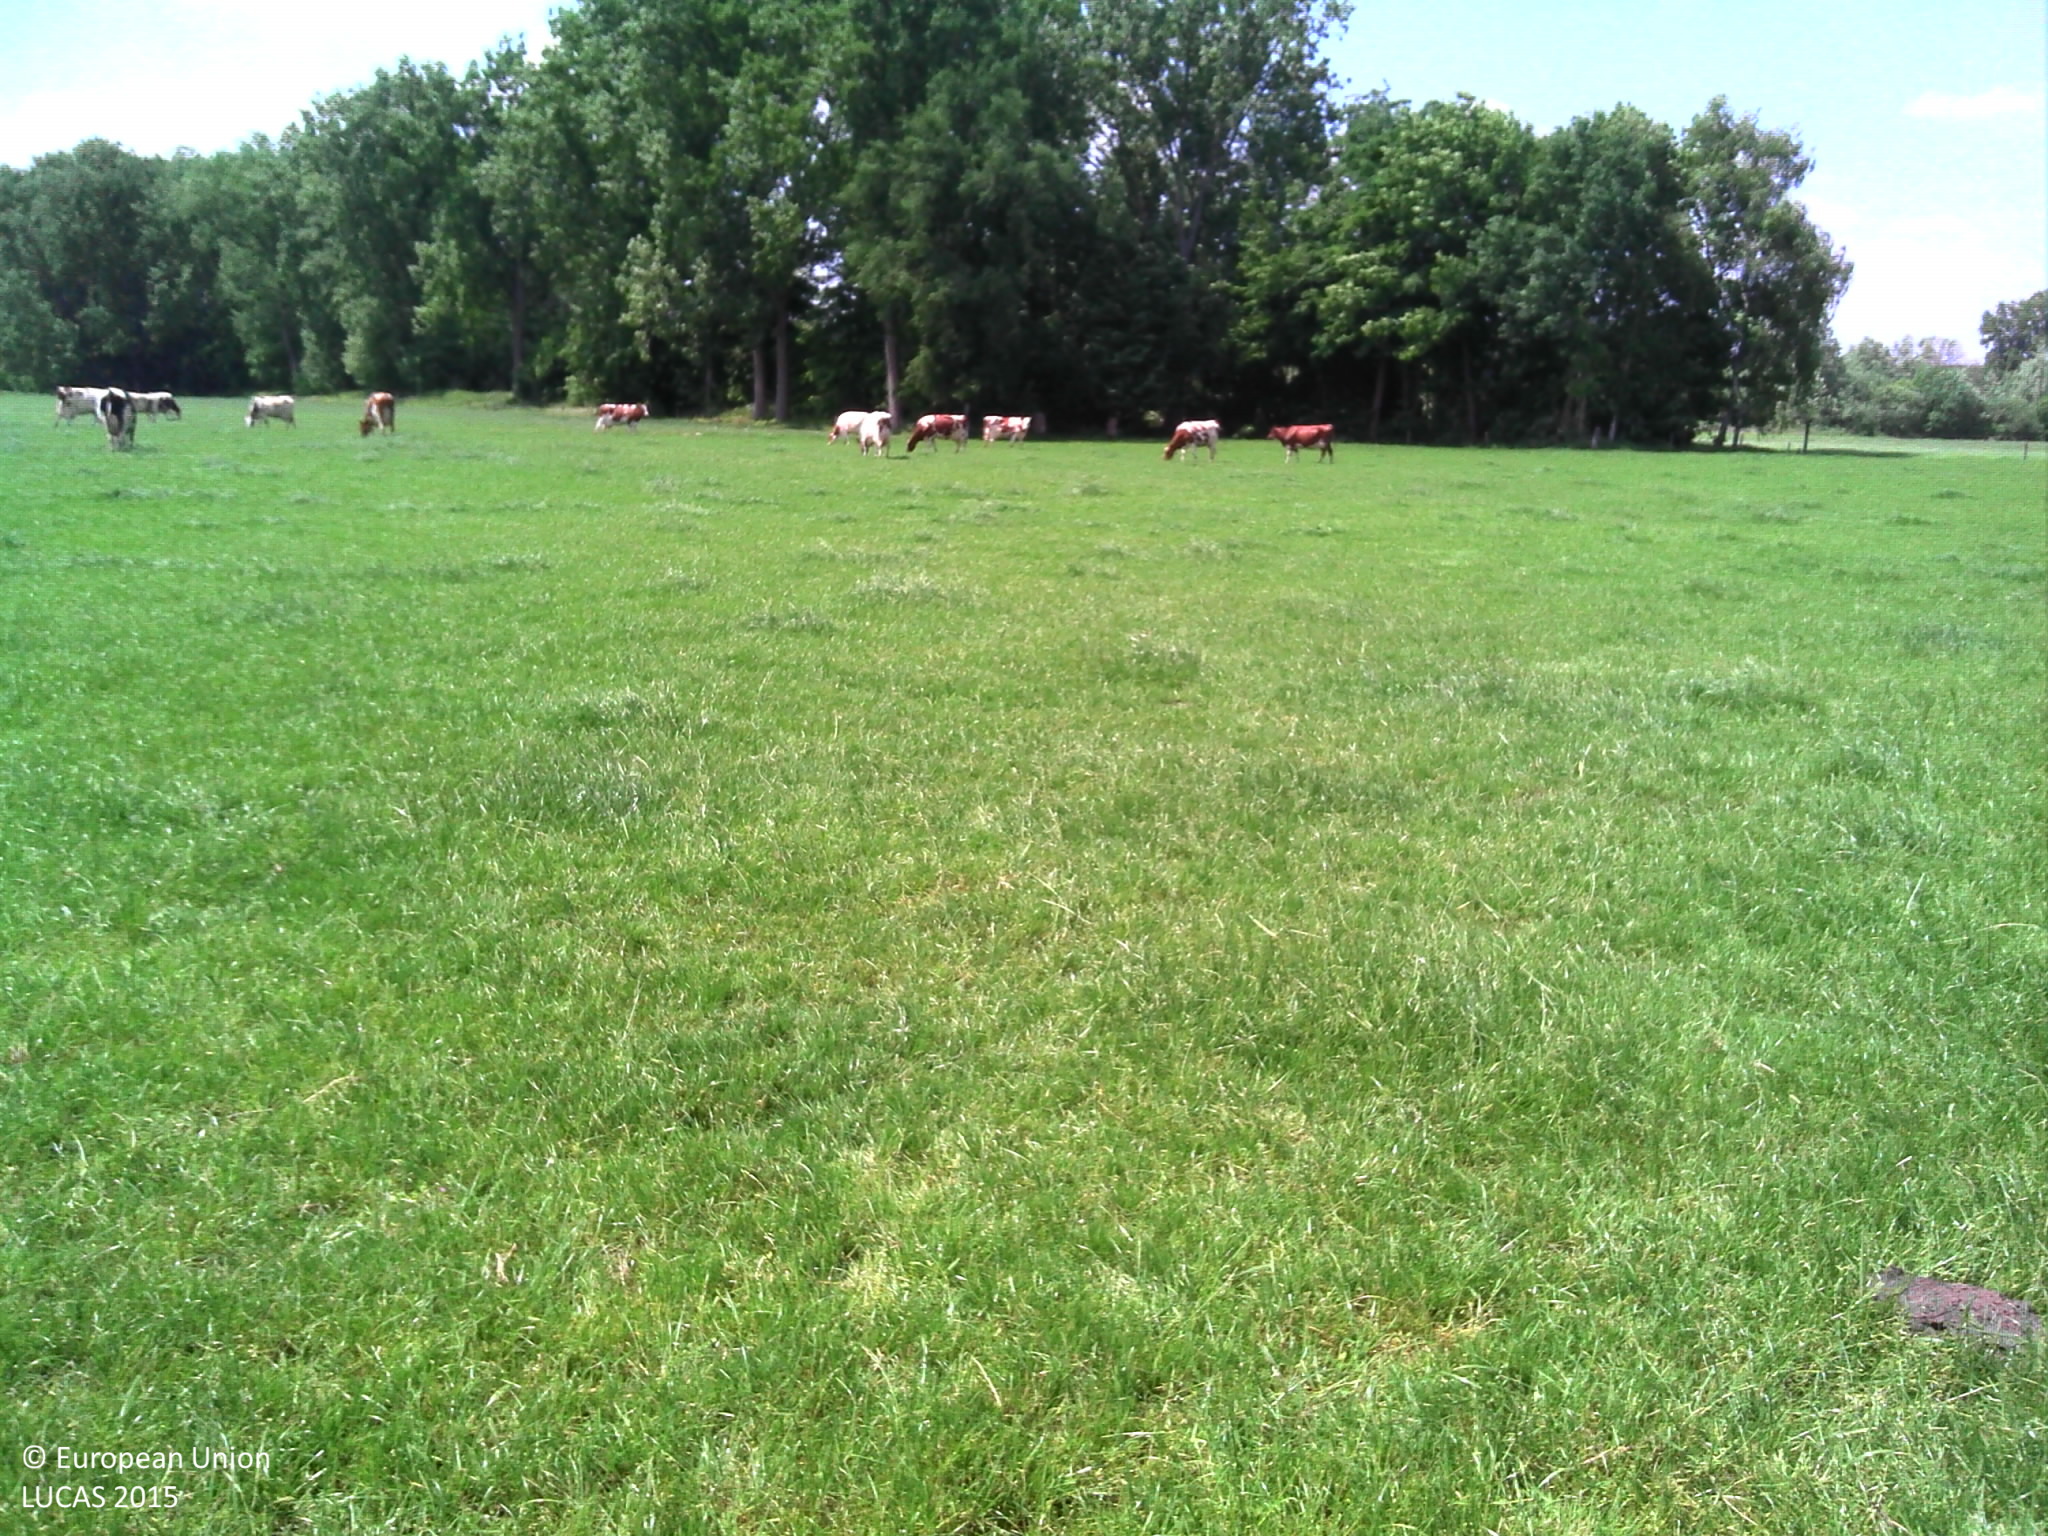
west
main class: Grassland
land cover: Grassland without tree/shrub cover
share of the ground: > 75 %
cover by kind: herbaceous plants 100 %
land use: Agriculture (excluding fallow land and kitchen gardens)
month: June
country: BE
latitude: 51.0369
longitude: 4.0188
